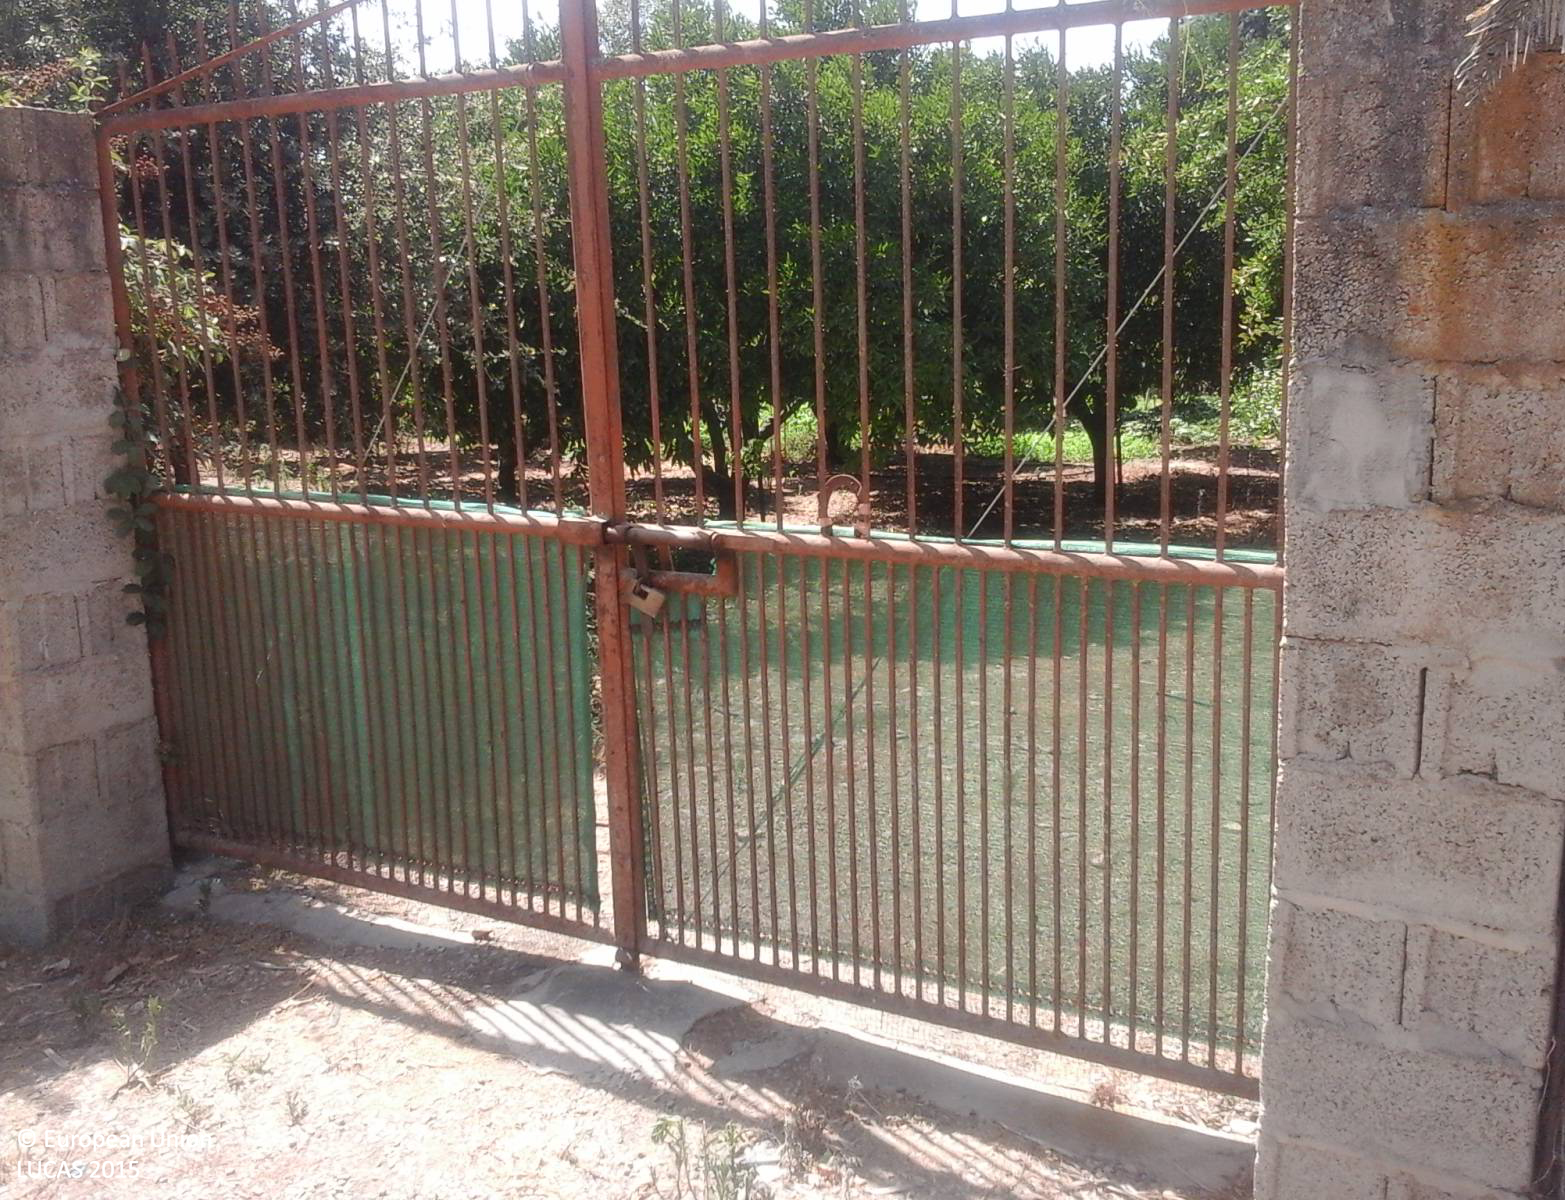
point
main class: Cropland
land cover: Oranges
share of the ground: > 75 %
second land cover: Grassland without tree/shrub cover
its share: > 75 %
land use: Agriculture (excluding fallow land and kitchen gardens)
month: August
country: IT
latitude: 39.4281
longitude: 8.9030
